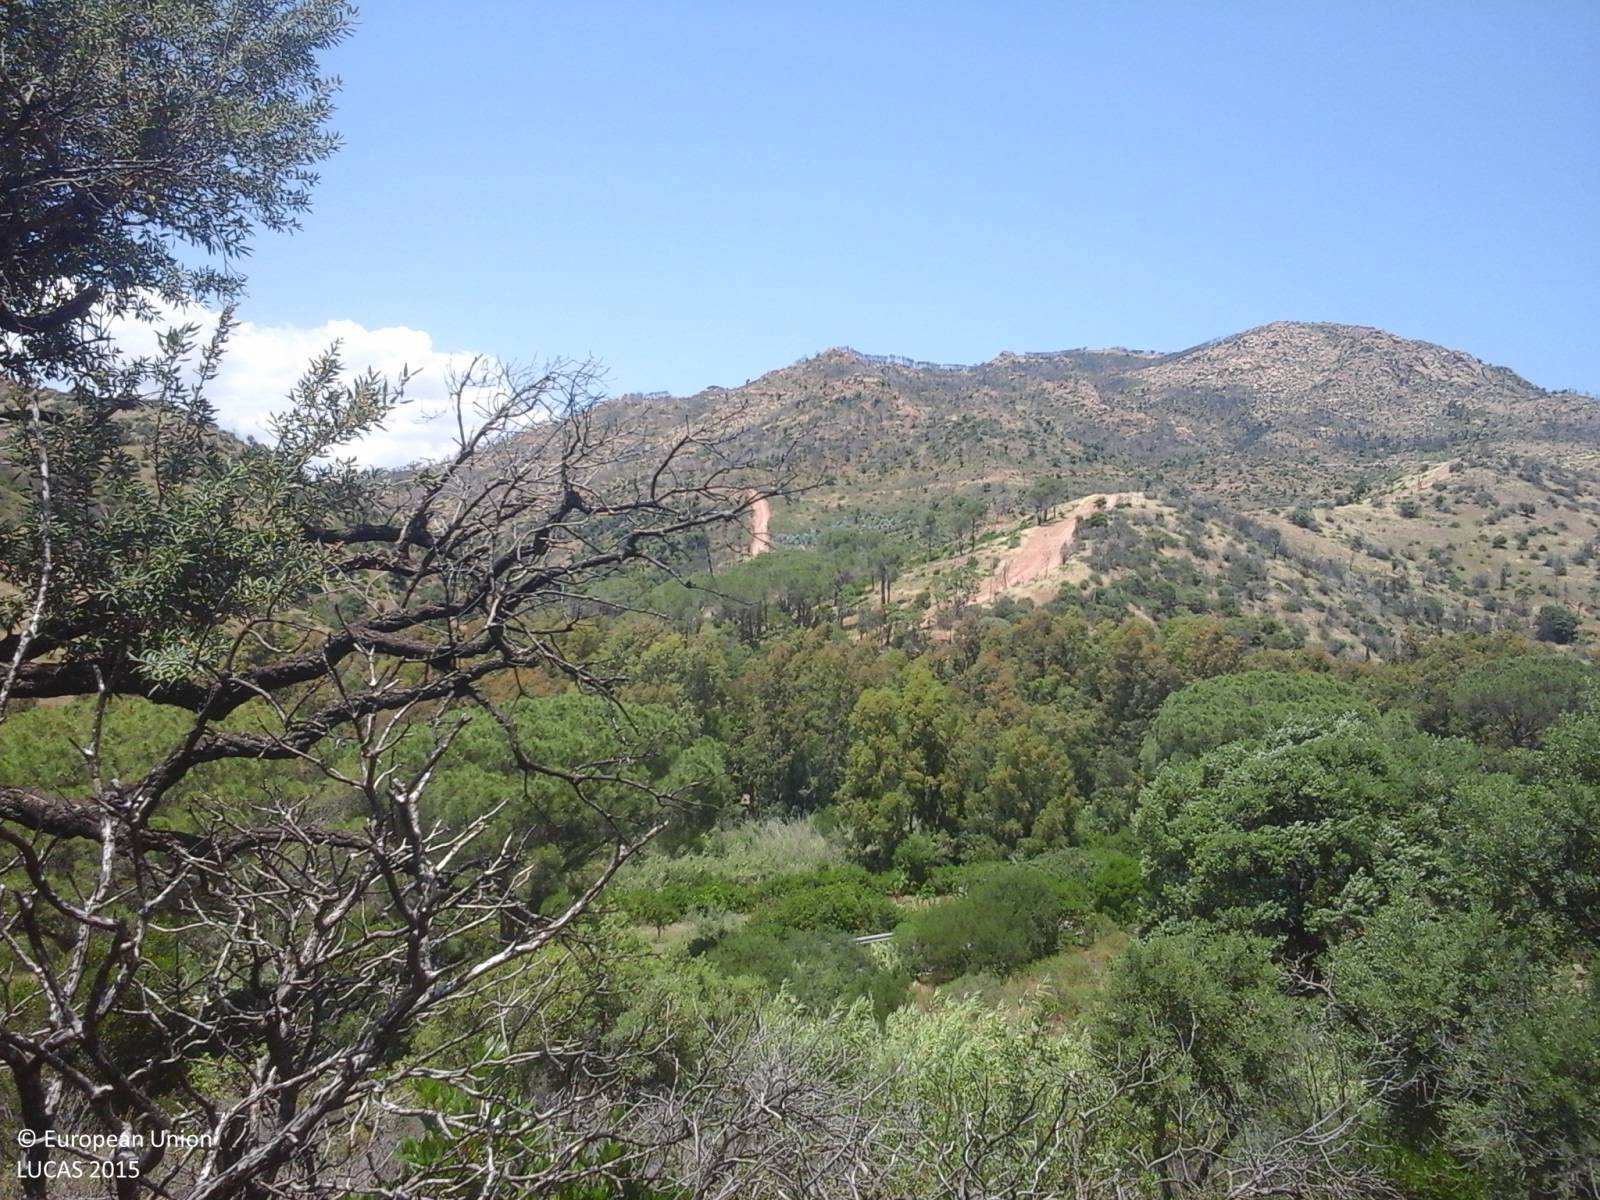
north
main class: Shrubland
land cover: Shrubland with sparse tree cover
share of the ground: > 75 %
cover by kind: herbaceous plants 80 %, shrubs 15 %, broadleaved forest trees 5 %
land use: Semi-natural and natural areas not in use
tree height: < 5 m
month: June
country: IT
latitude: 39.2871
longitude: 9.3432
